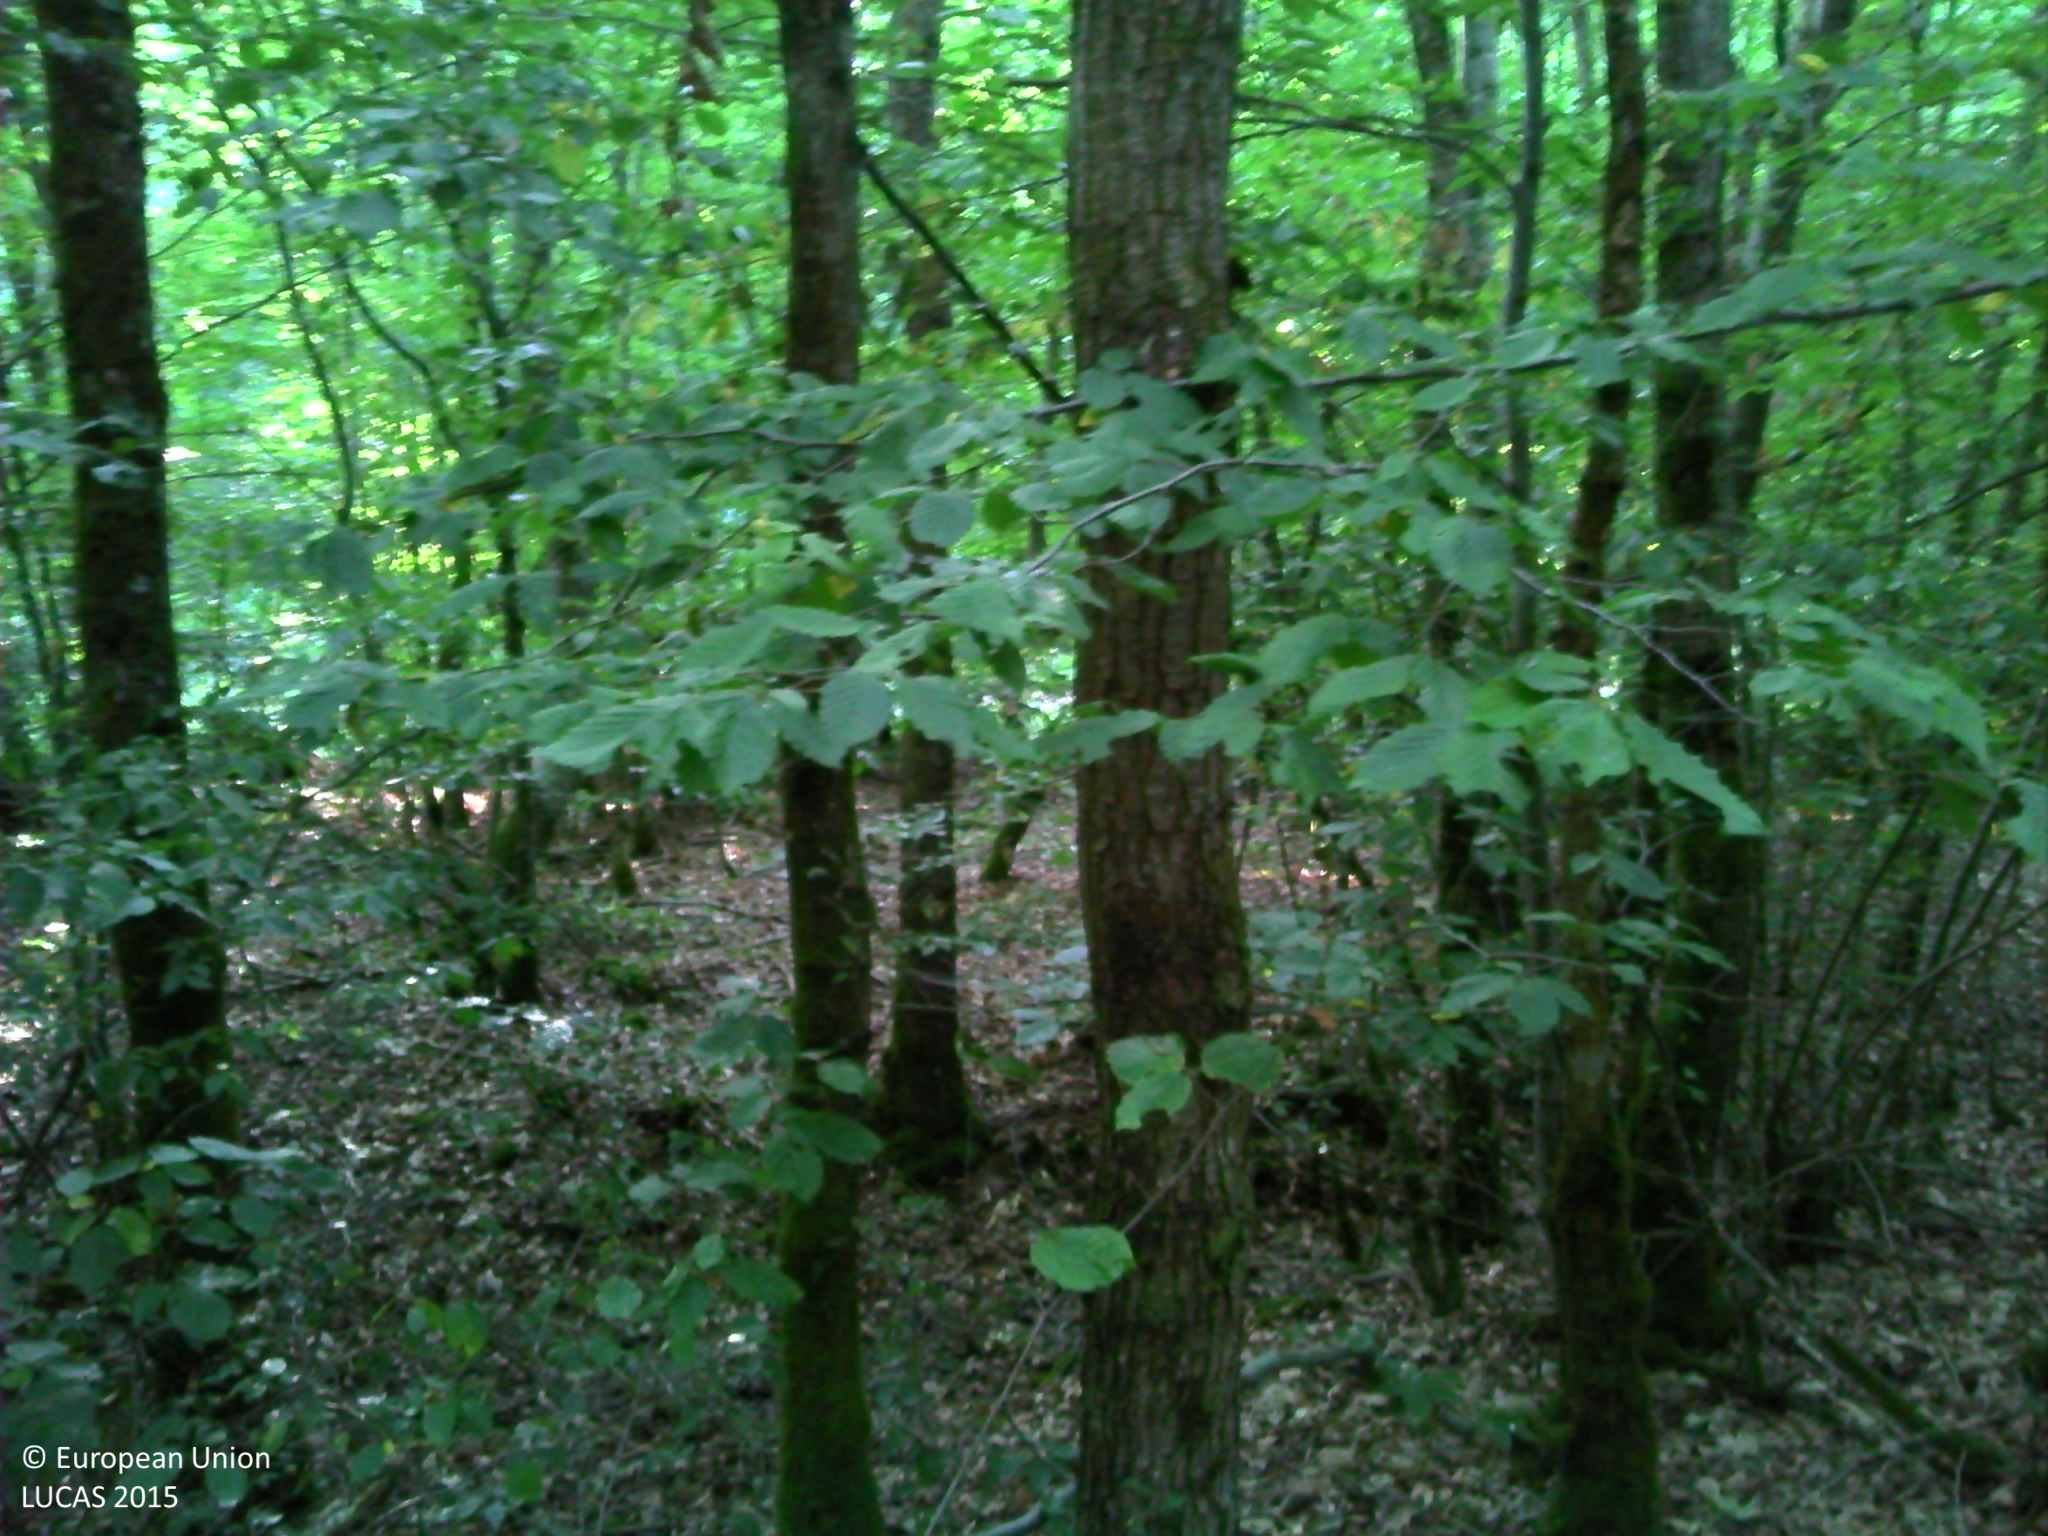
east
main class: Woodland
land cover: Broadleaved woodland
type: acidophilous oak and oak-birch forest
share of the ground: > 75 %
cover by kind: broadleaved forest trees 90 %, herbaceous plants 5 %, lichens and mosses 5 %
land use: Forestry
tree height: > 5 m
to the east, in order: Broadleaved woodland; Ditches and canals; Grass margins; Tracks; Grass margins; Broadleaved woodland; Tracks; Broadleaved woodland
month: July
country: FR
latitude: 48.5305
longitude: 6.0322
